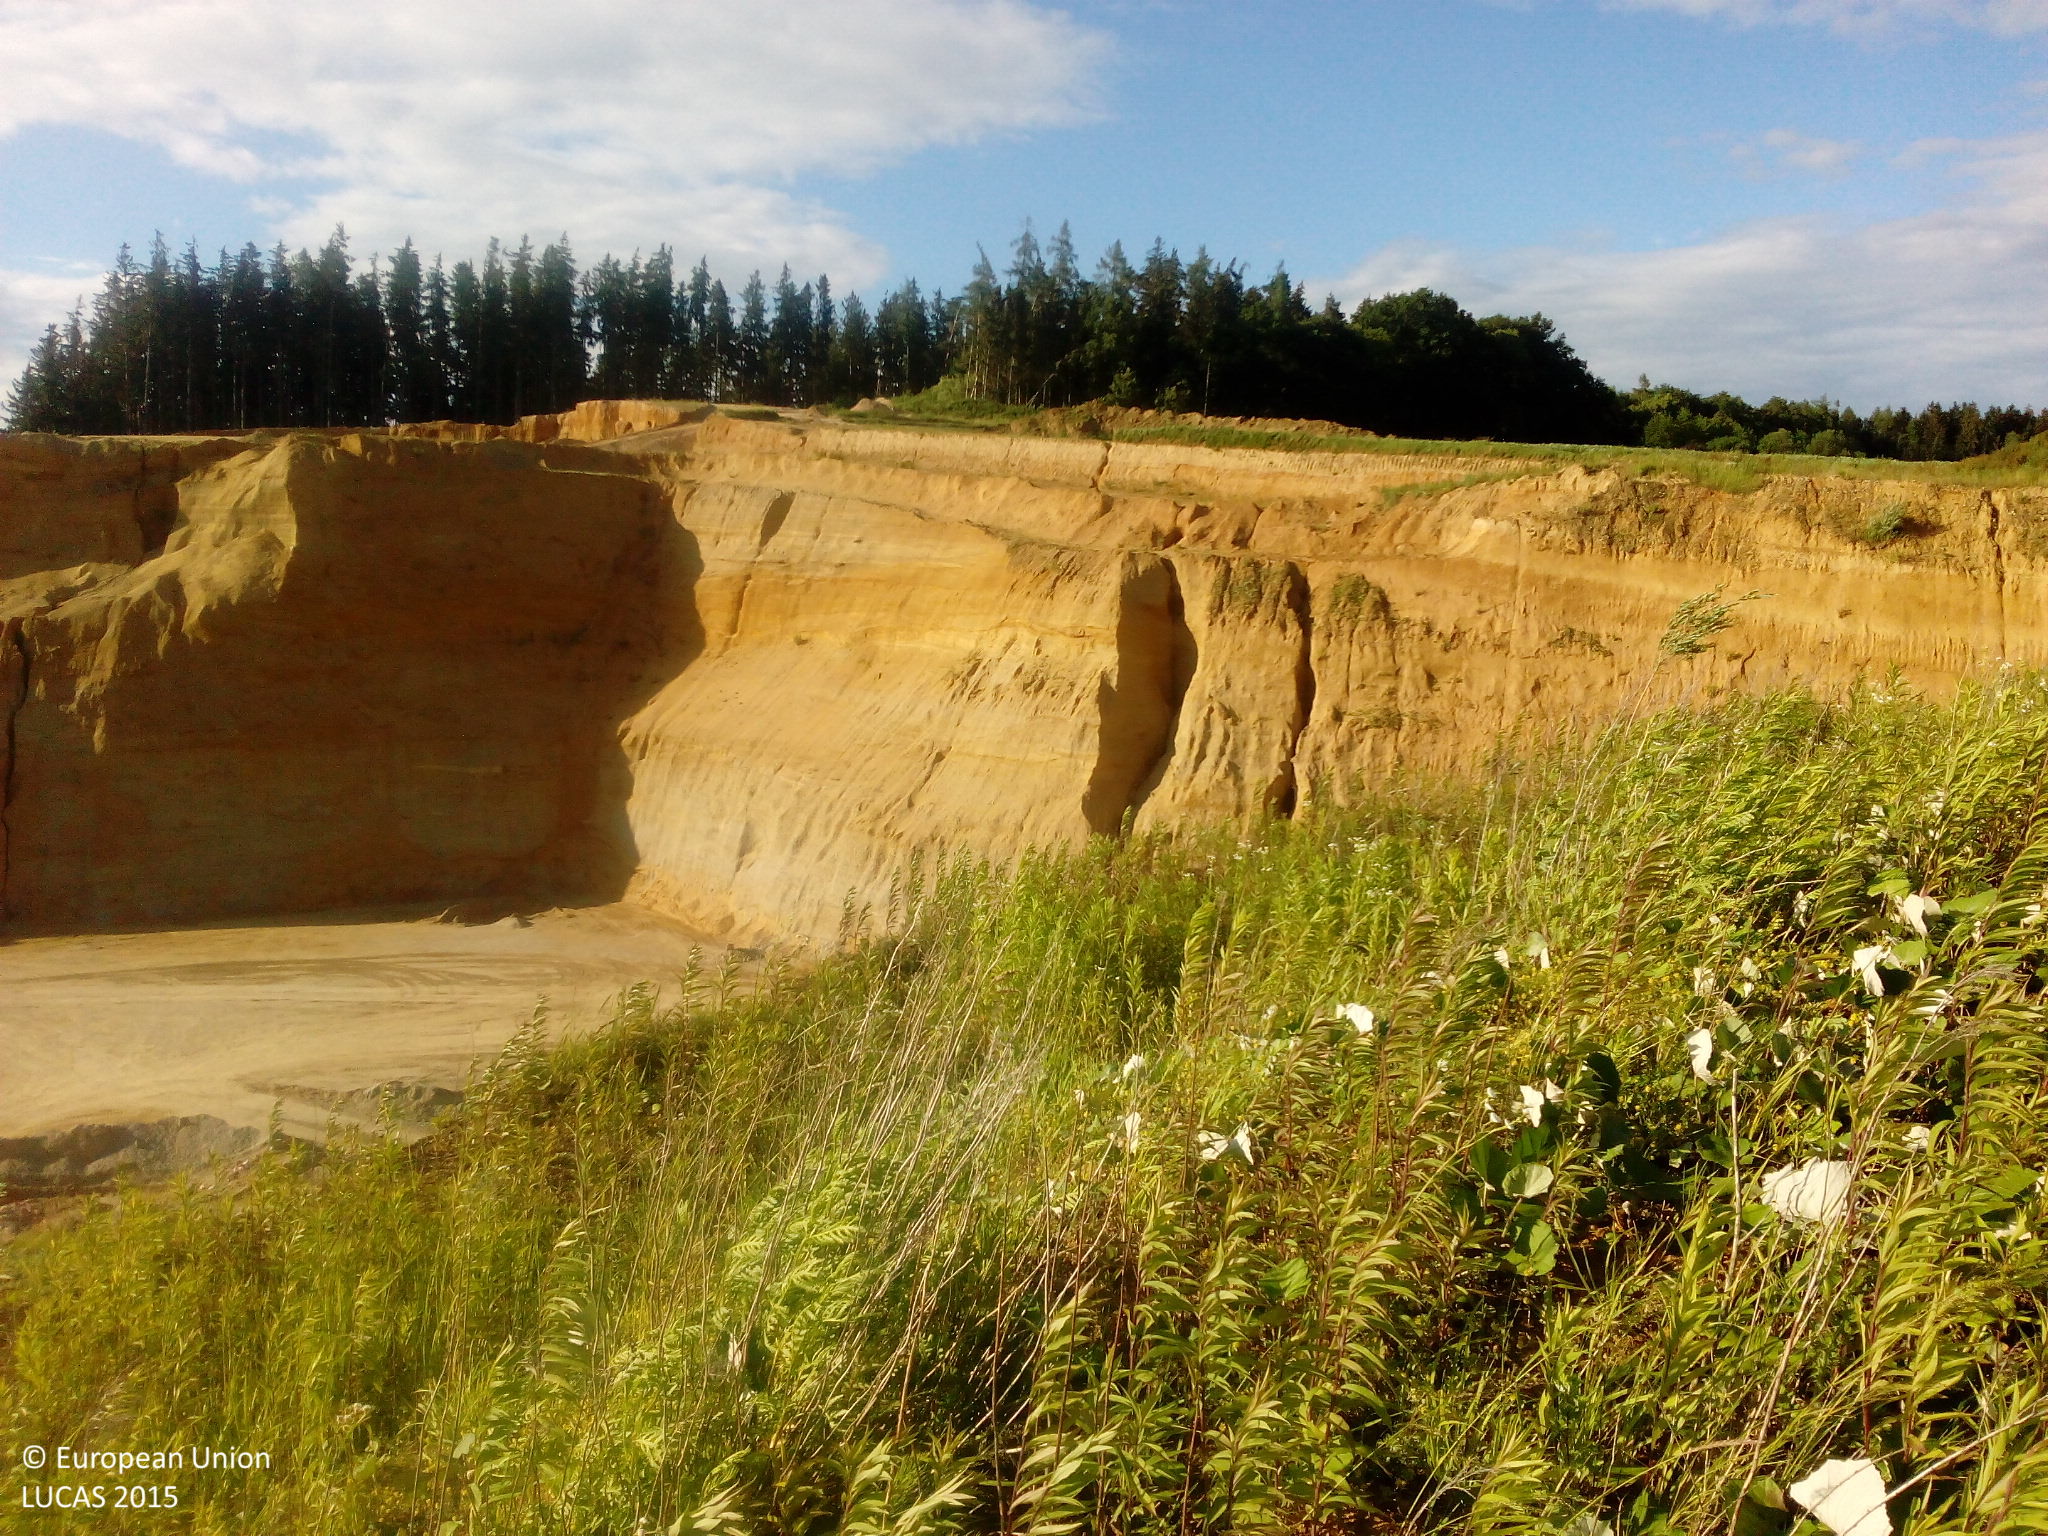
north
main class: Grassland
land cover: Spontaneously vegetated surfaces
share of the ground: 10 - 25 %
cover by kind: unconsolidated bare surface 80 %, herbaceous plants 20 %
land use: Mining and quarrying
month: June
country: DE
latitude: 48.5821
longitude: 12.0732
